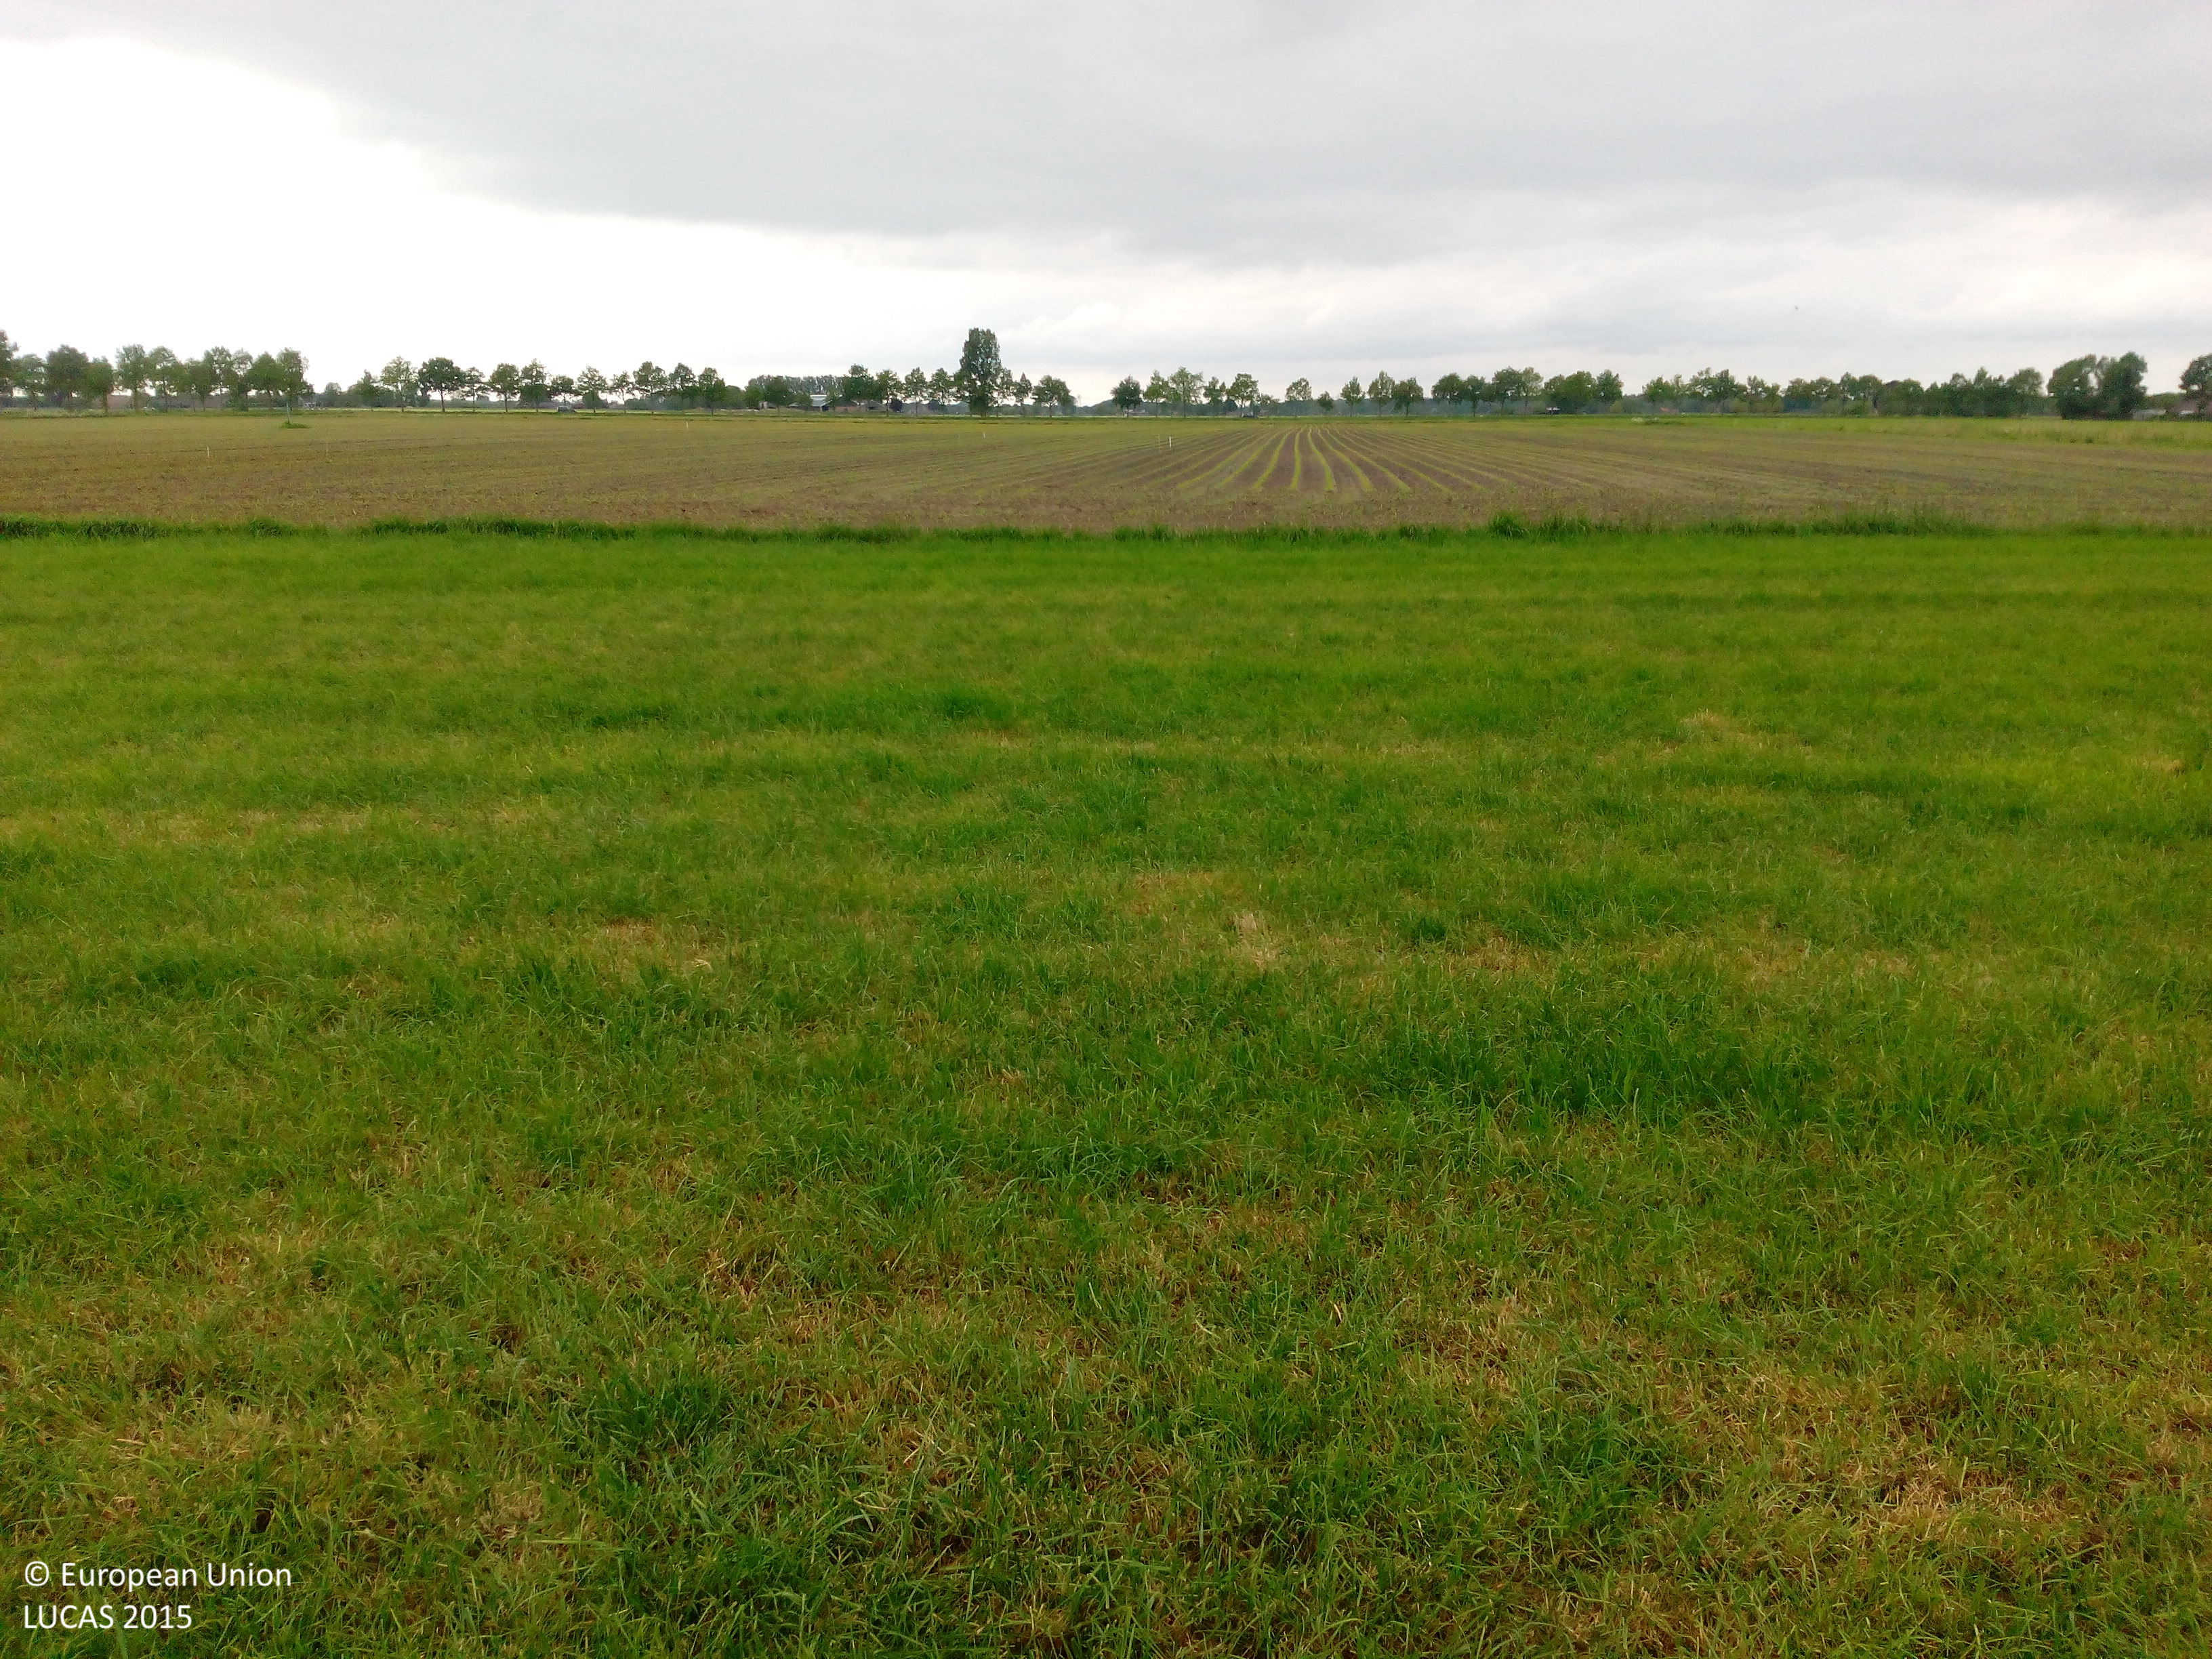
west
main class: Grassland
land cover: Grassland without tree/shrub cover
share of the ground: > 75 %
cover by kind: herbaceous plants 100 %
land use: Agriculture (excluding fallow land and kitchen gardens)
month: May
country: NL
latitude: 52.3705
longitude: 6.1953
